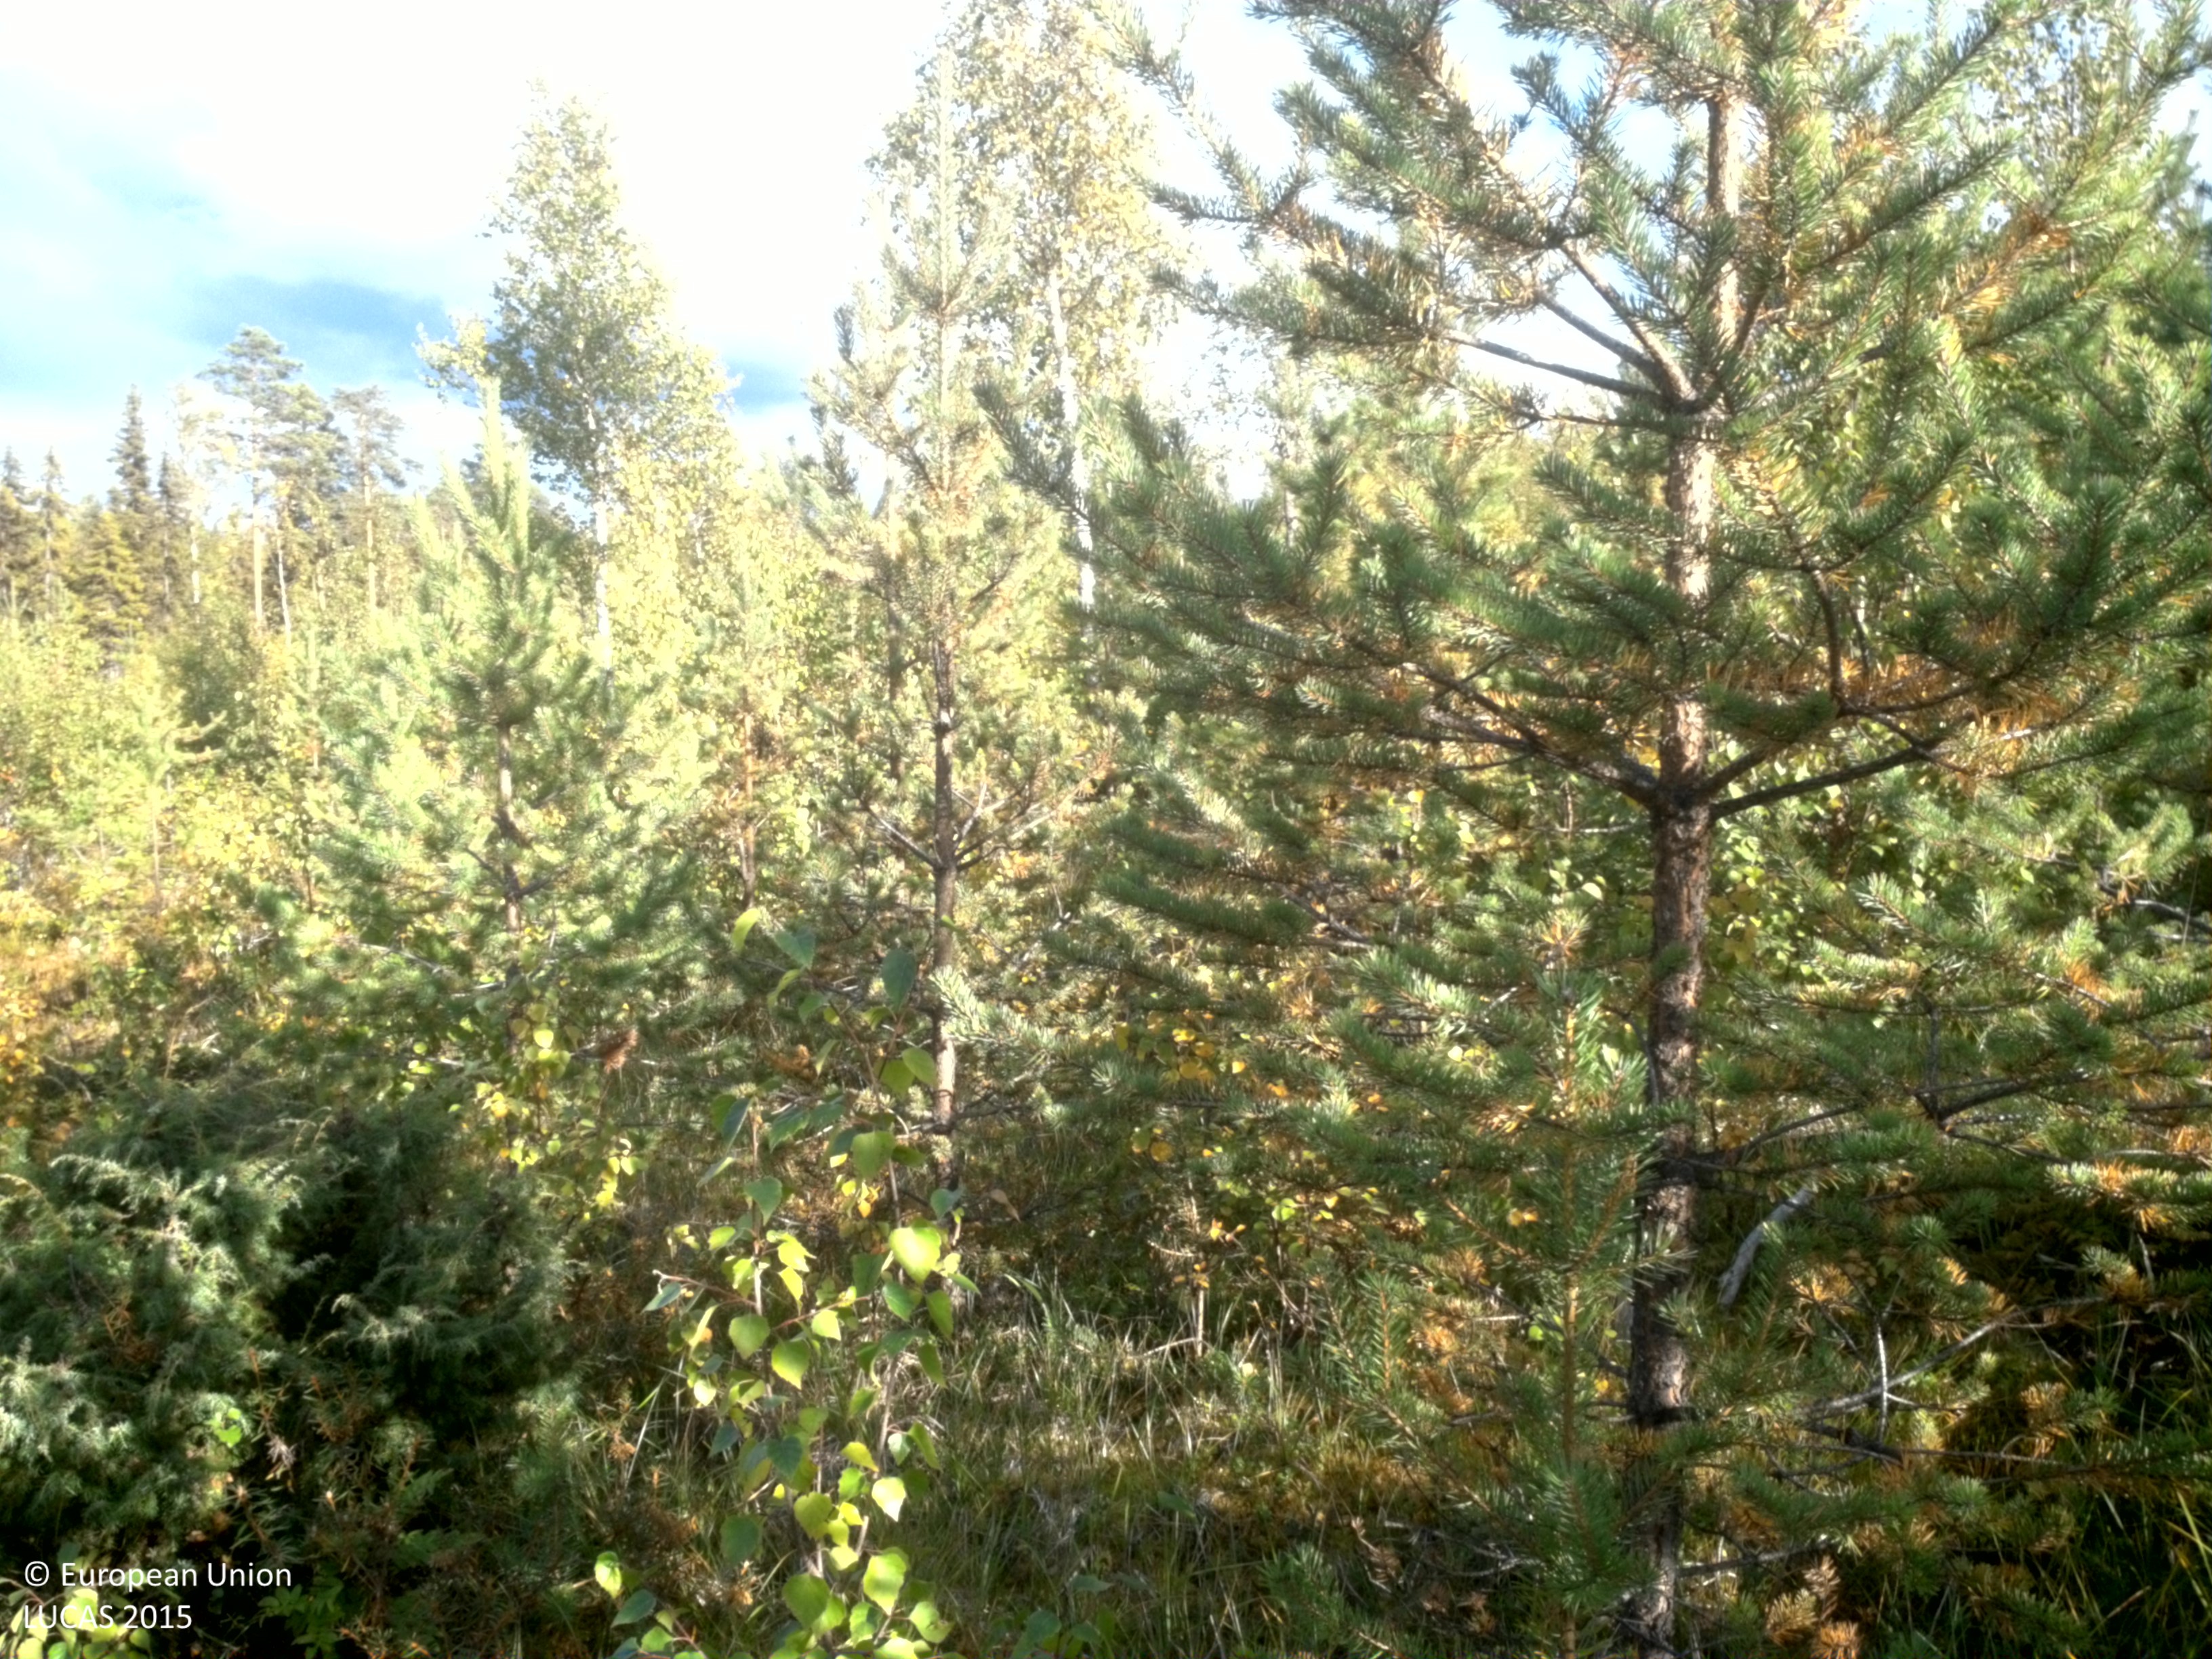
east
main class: Woodland
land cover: Other mixed woodland
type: boreal forest
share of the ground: 50 - 75 %
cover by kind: coniferous forest trees 45 %, broadleaved forest trees 25 %, shrubs 10 %, herbaceous plants 10 %, lichens and mosses 10 %
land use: Forestry
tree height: < 5 m
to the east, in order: Other mixed woodland; Spruce dominated mixed woodland; Other mixed woodland; Broadleaved woodland; Ditches and canals; Broadleaved woodland
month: September
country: SE
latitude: 64.4572
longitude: 19.2206
